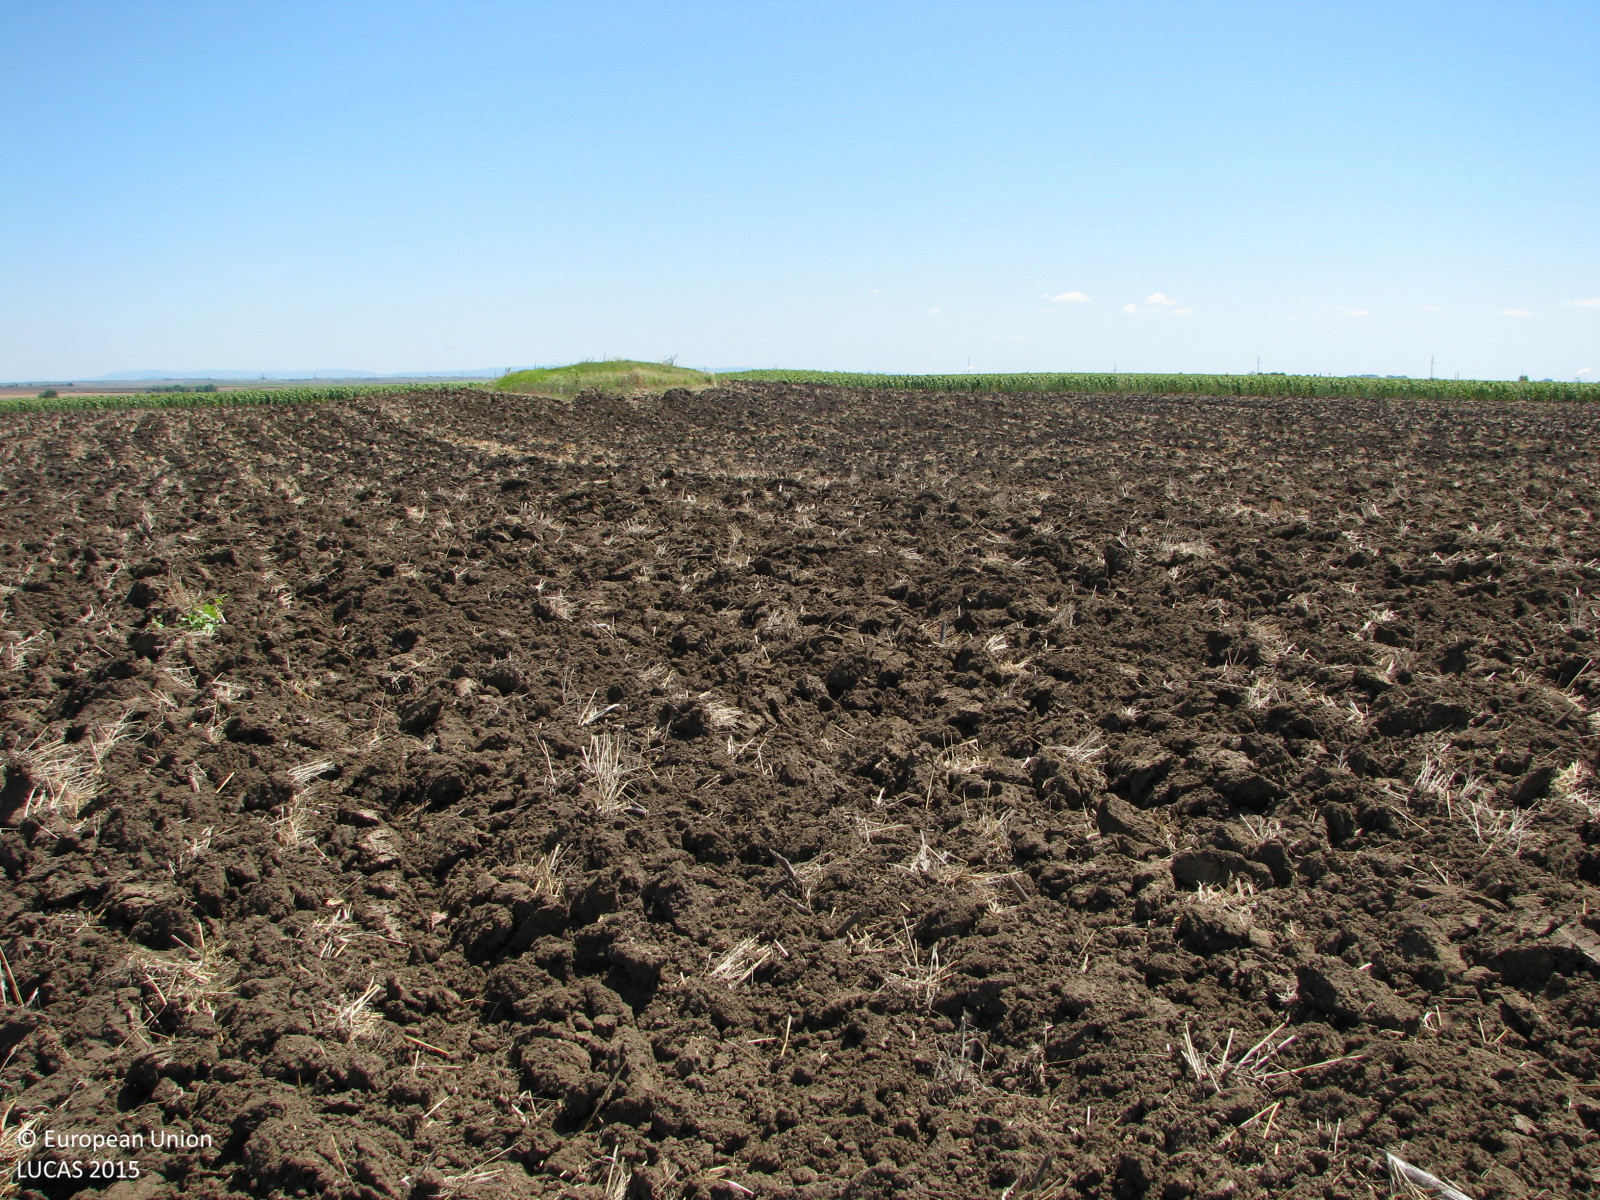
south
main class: Cropland
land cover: Common wheat
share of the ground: < 10 %
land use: Agriculture (excluding fallow land and kitchen gardens)
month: July
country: BG
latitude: 42.3550
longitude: 25.9455
